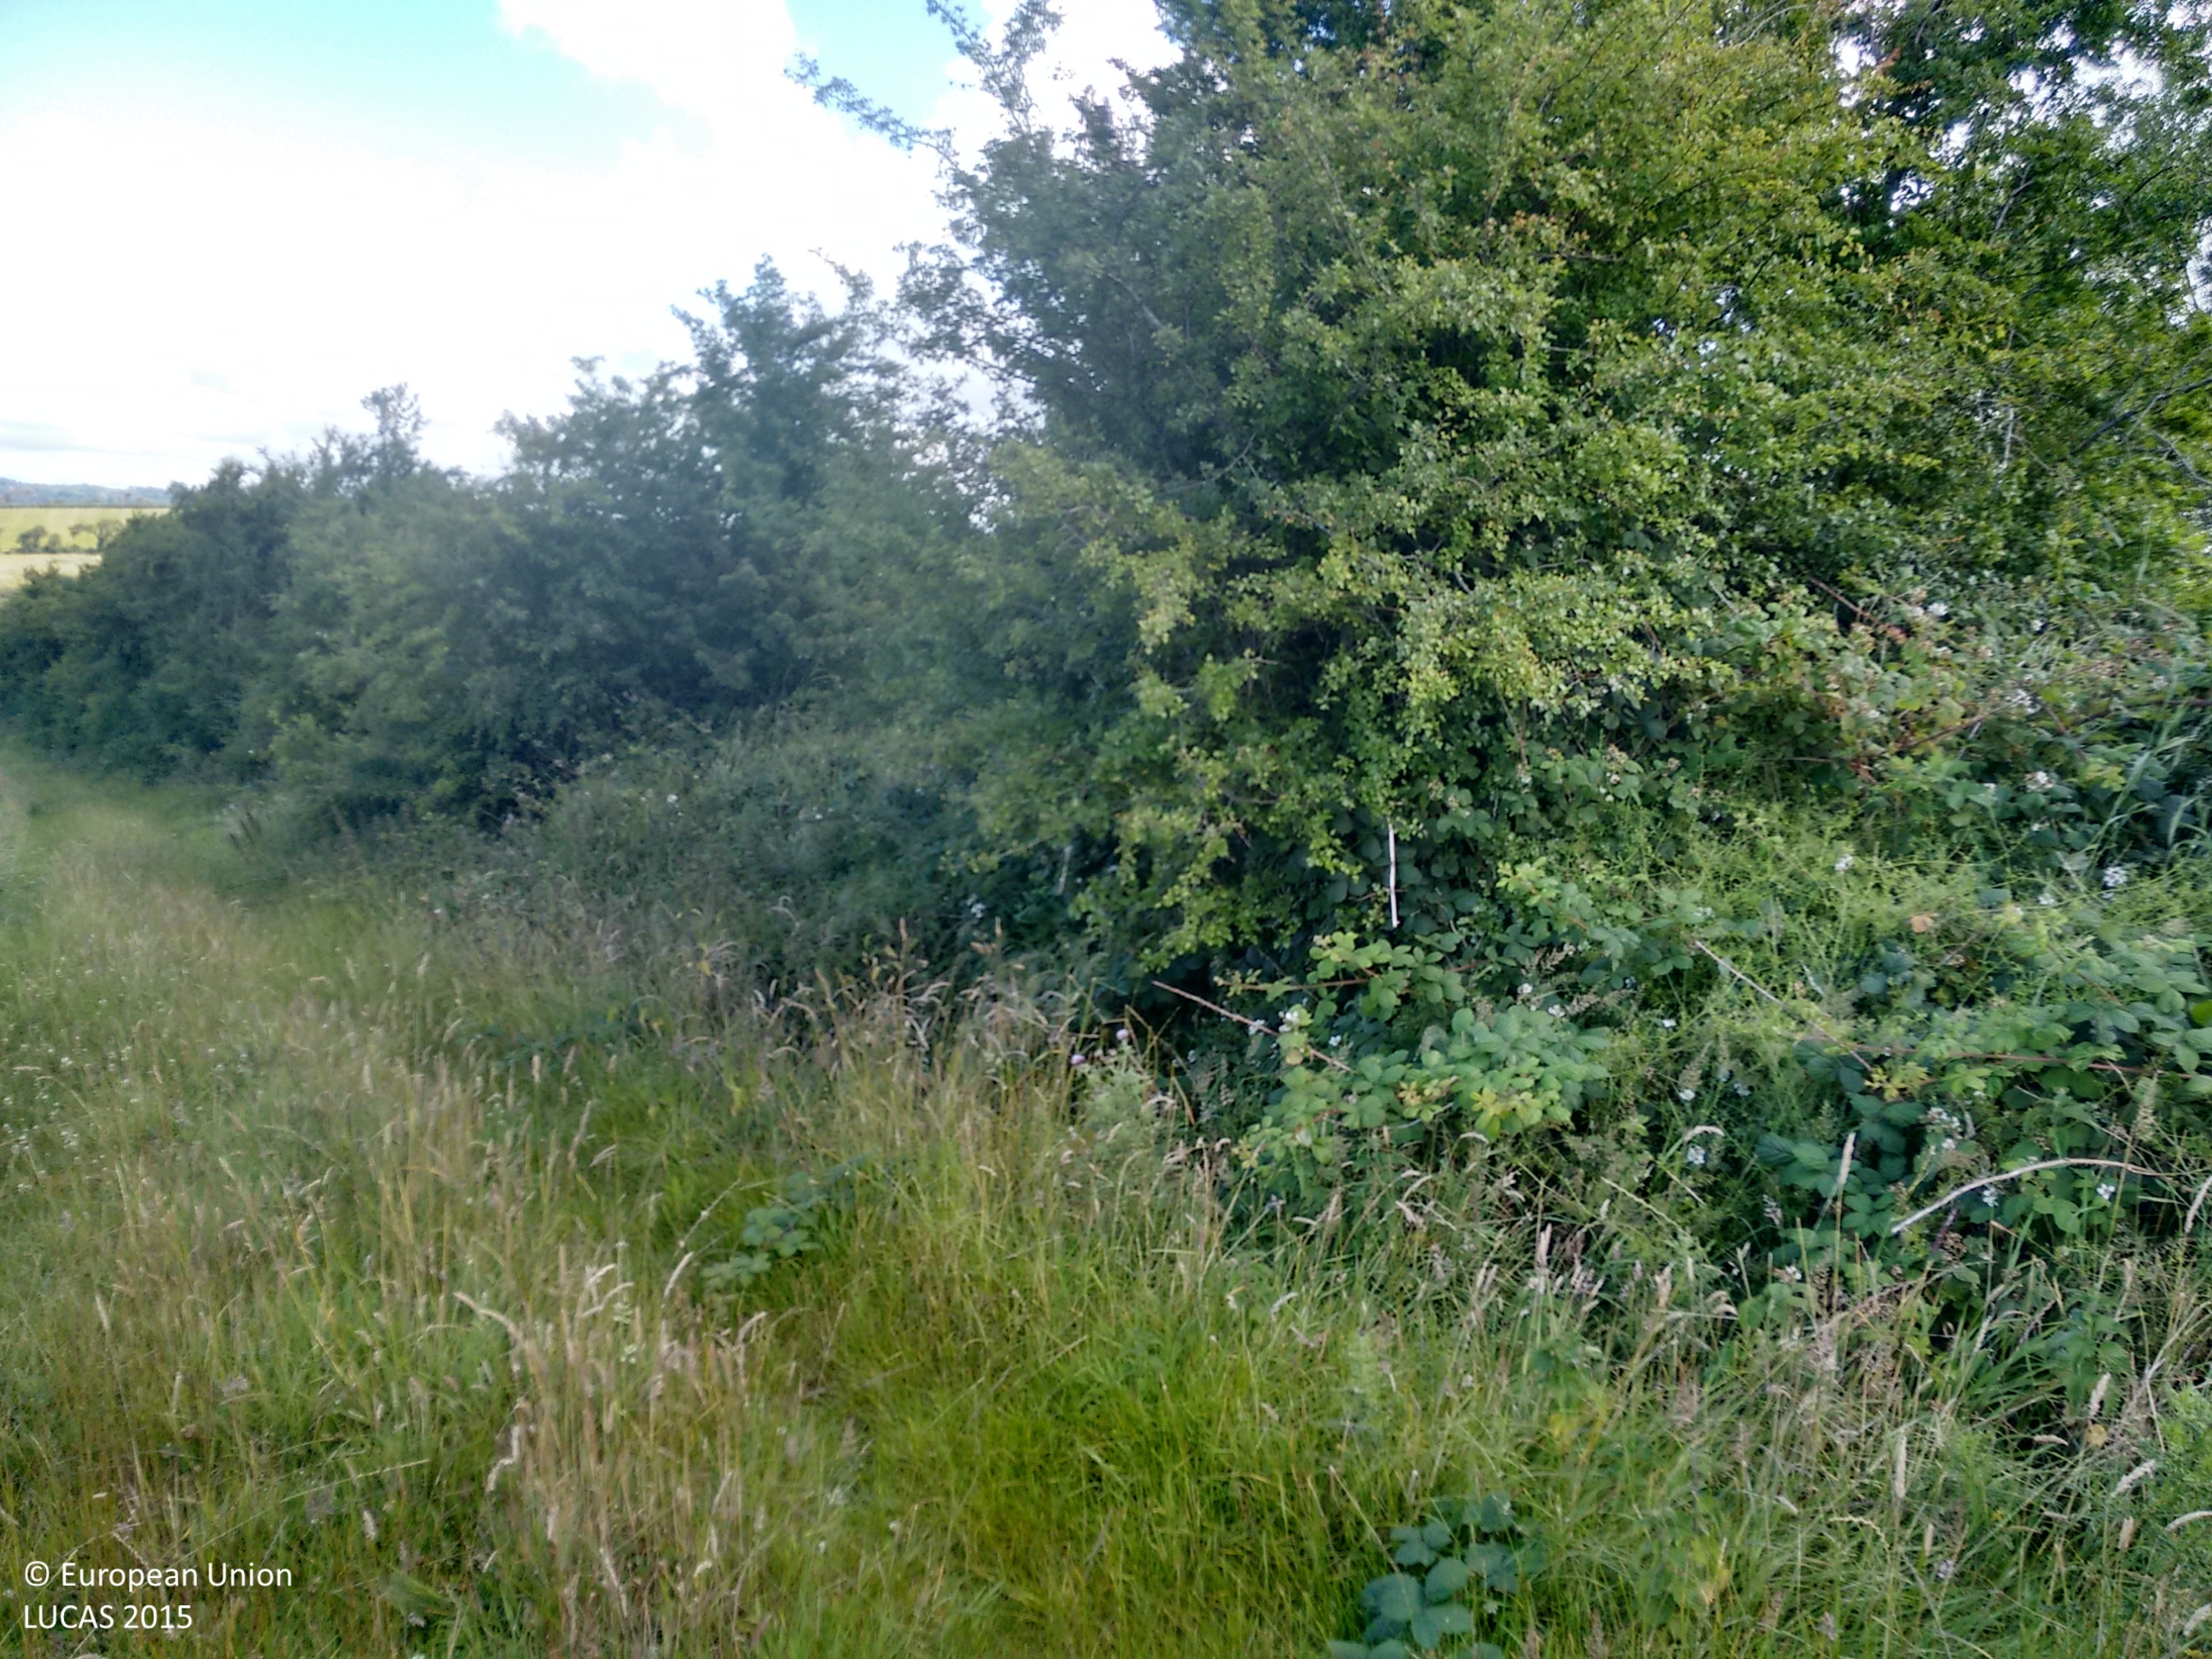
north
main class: Grassland
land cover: Grassland without tree/shrub cover
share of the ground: > 75 %
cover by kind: herbaceous plants 100 %
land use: Agriculture (excluding fallow land and kitchen gardens)
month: July
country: IE
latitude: 52.2123
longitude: -8.8679
